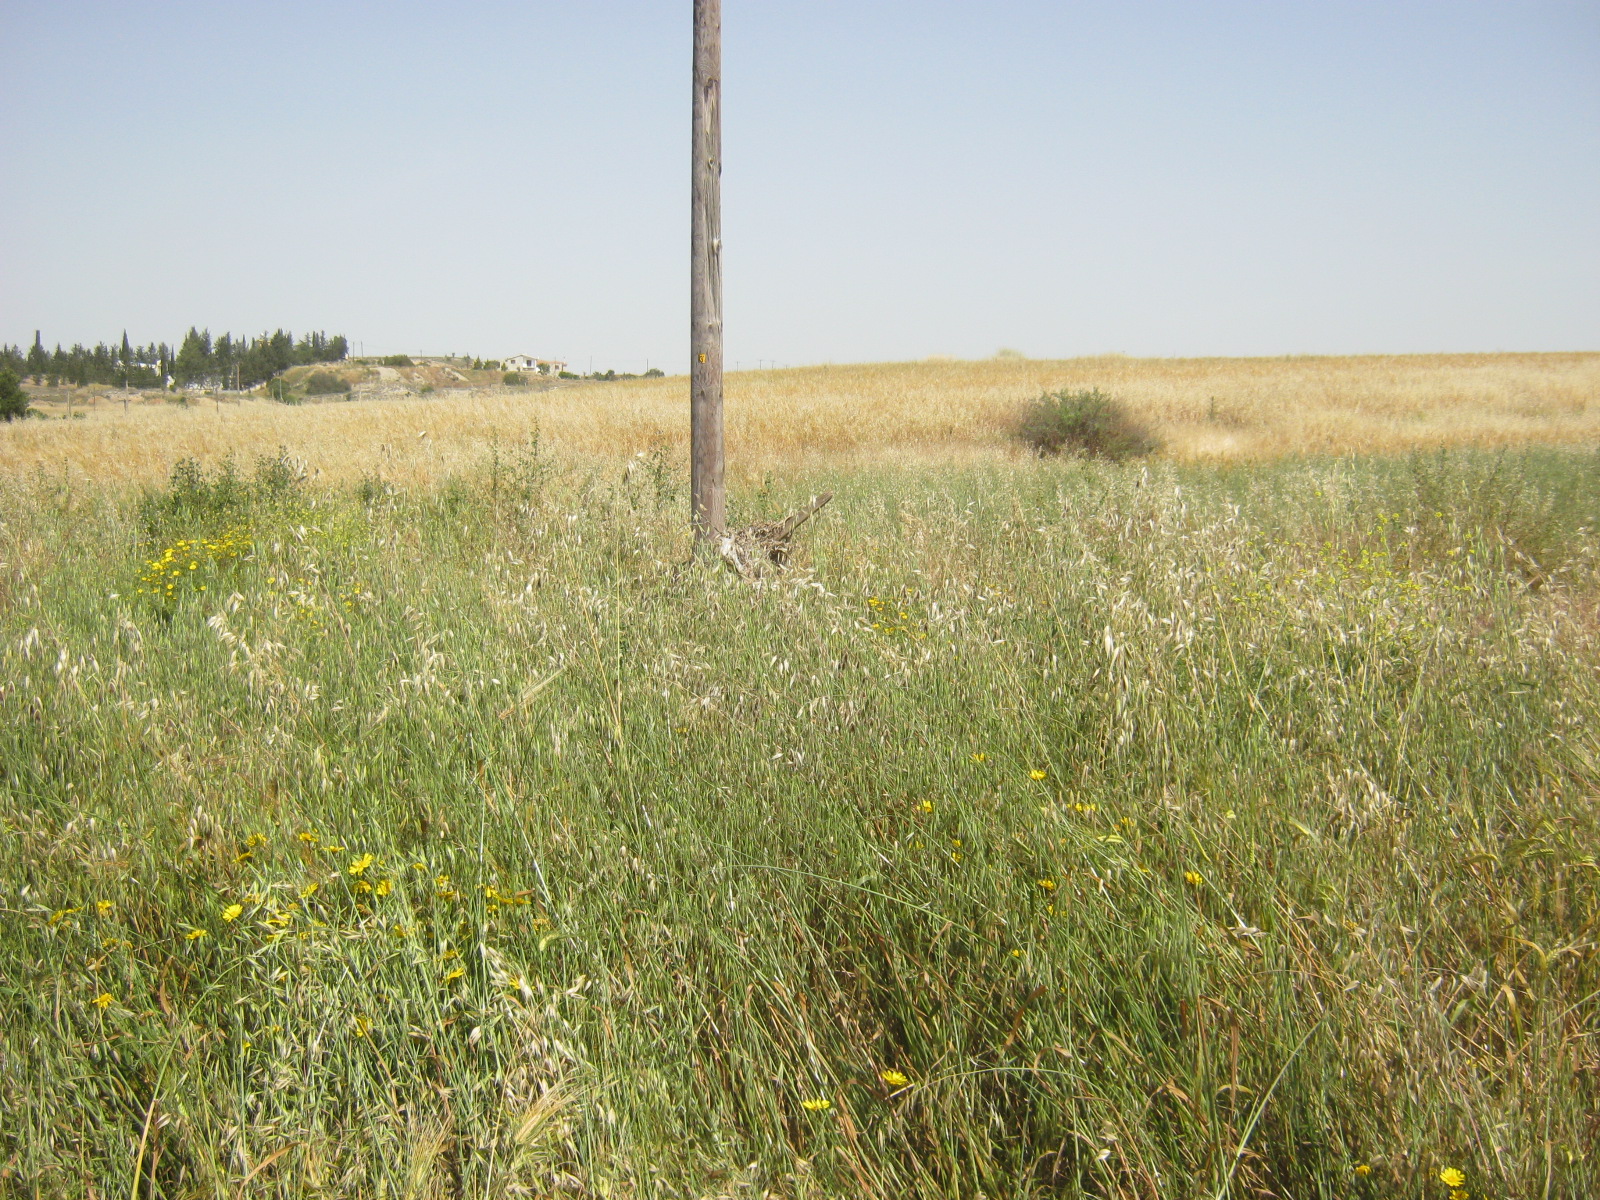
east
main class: Cropland
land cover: Mixed cereals for fodder
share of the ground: > 75 %
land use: Agriculture (excluding fallow land and kitchen gardens)
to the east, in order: Mixed cereals for fodder; Paved roads, cycling and walking lanes; Electric lines; Grass margins; Rivers and streams; Grassland with sparse tree/shrub cover; Tracks; Common wheat; Shrubland without tree cover; Rivers and streams; Shrubland without tree cover; Barley; Grass margins; Electric lines; Paved roads, cycling and walking lanes
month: April
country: CY
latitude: 35.1200
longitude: 33.2642
